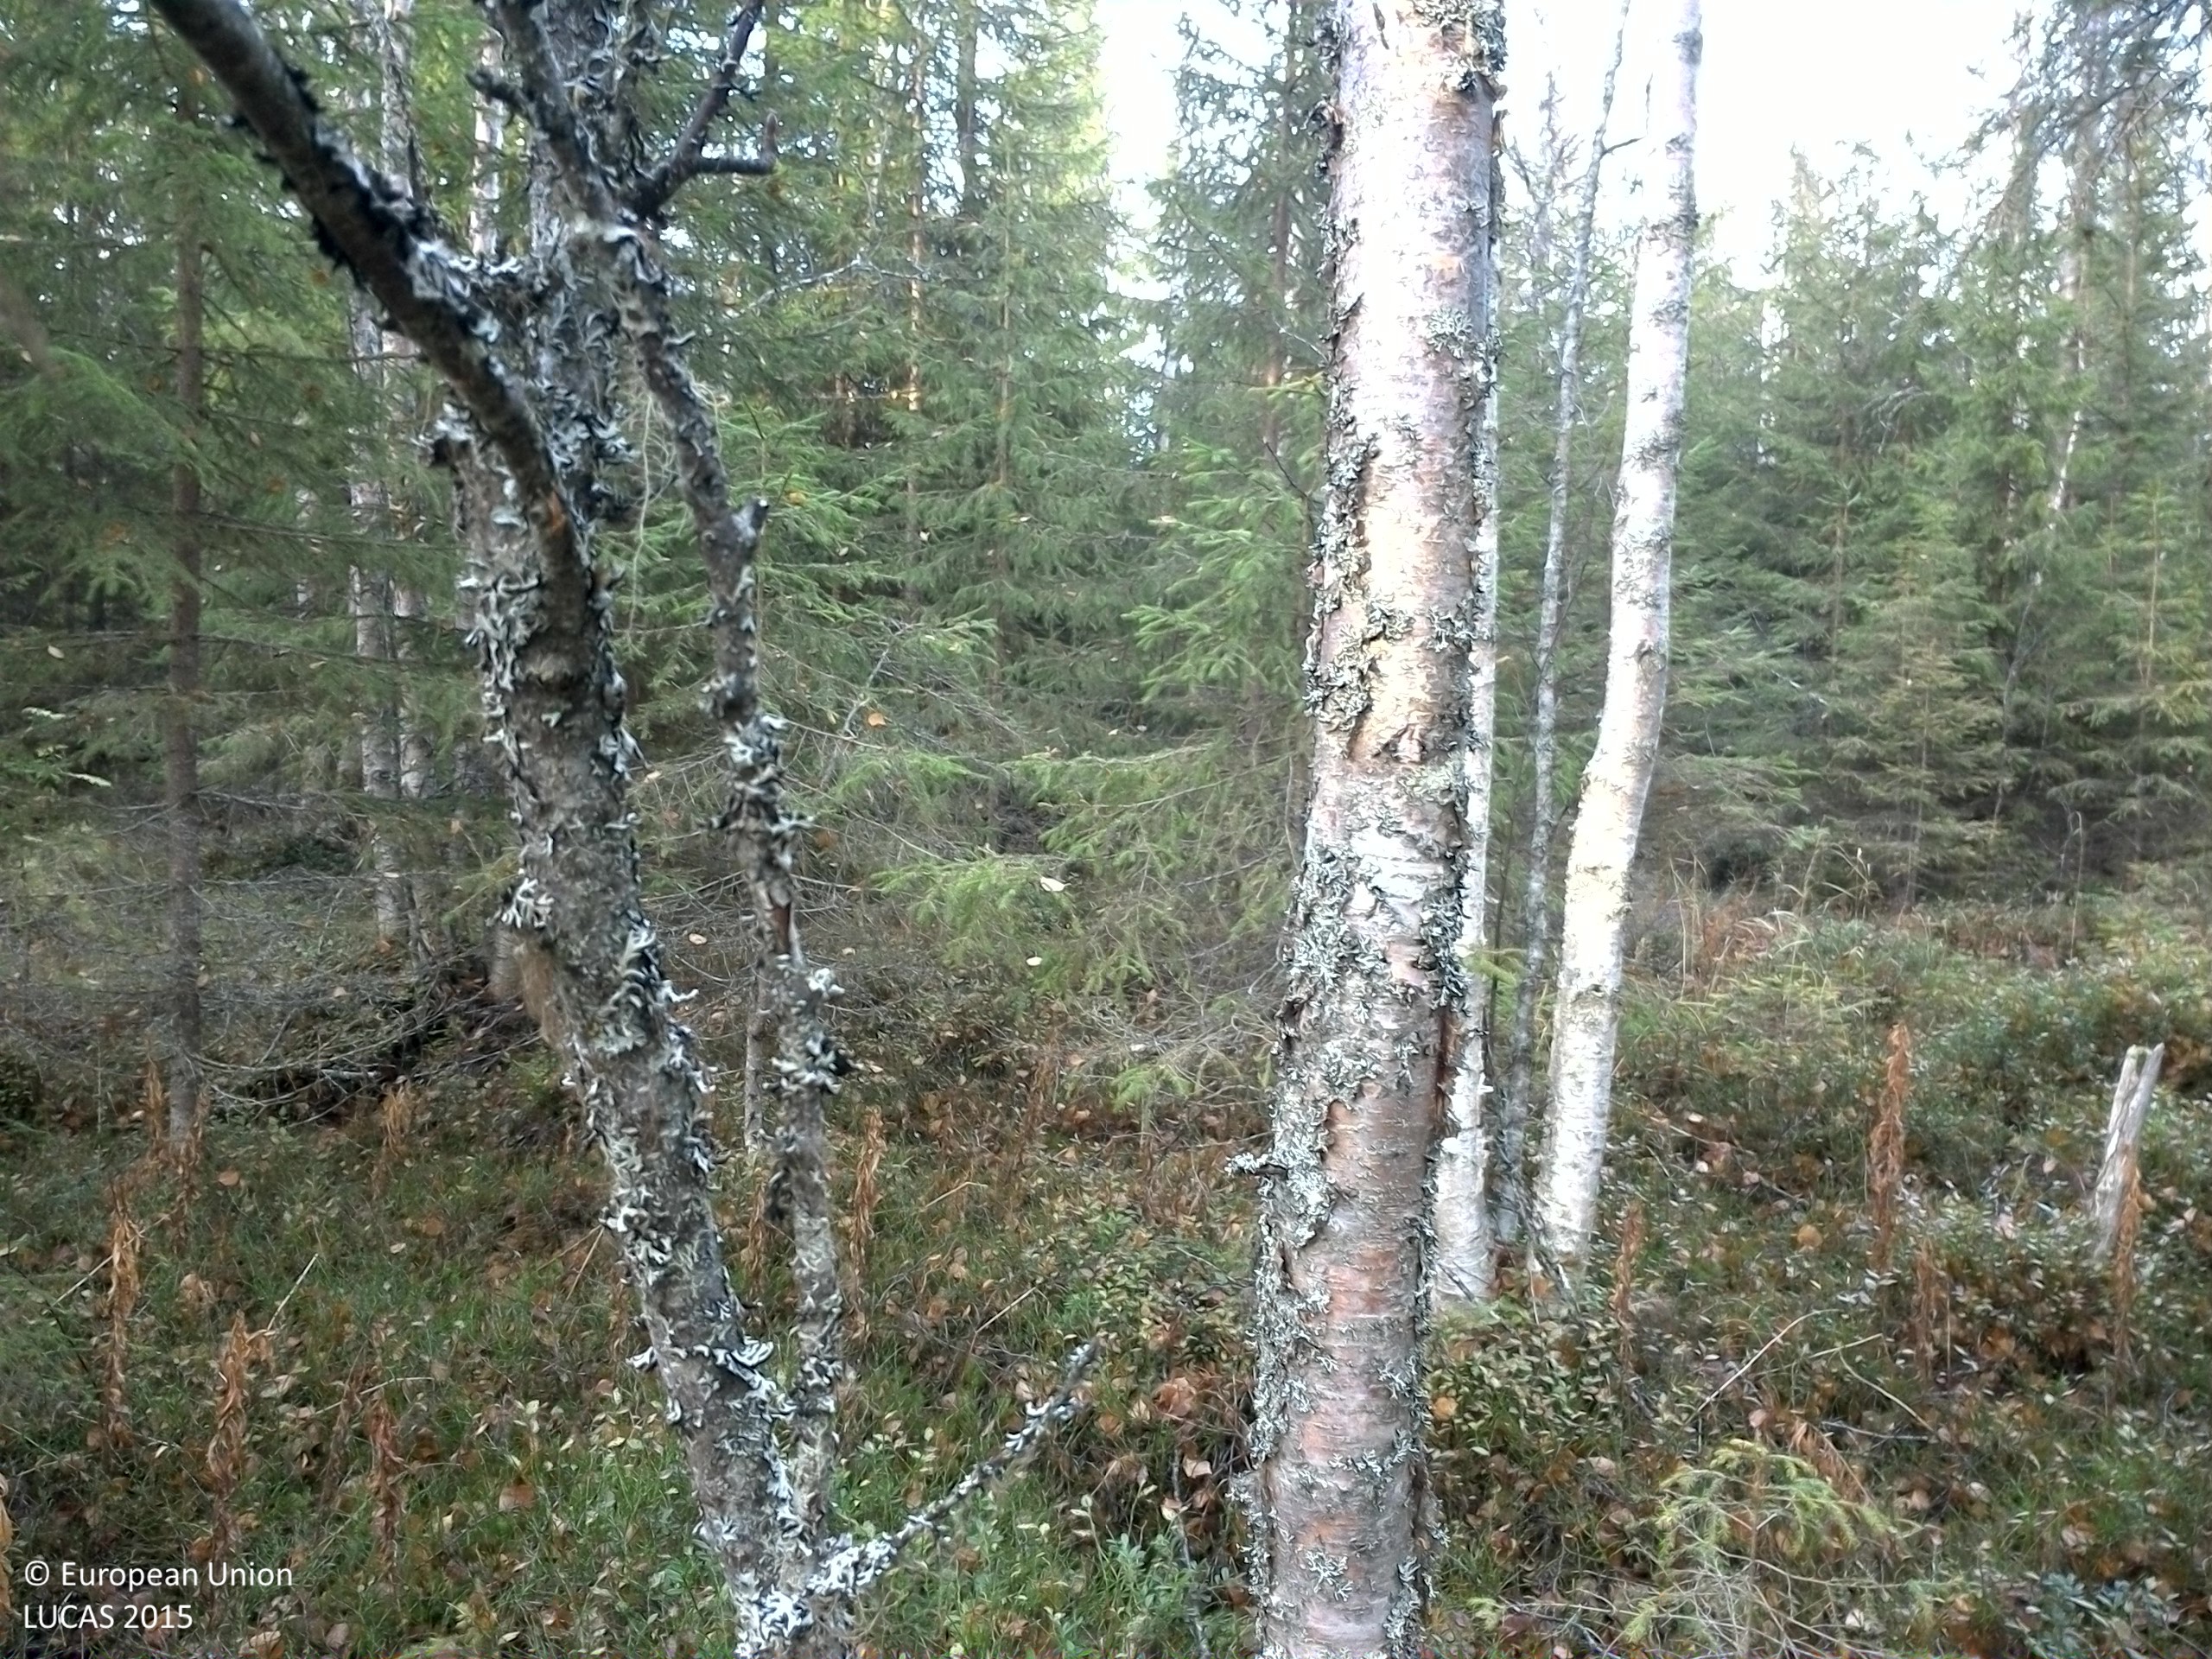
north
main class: Woodland
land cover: Spruce dominated mixed woodland
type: boreal forest
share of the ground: 50 - 75 %
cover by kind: coniferous forest trees 50 %, broadleaved forest trees 20 %, shrubs 20 %, lichens and mosses 10 %
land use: Forestry
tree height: > 5 m
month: October
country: SE
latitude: 64.1432
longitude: 15.9102
